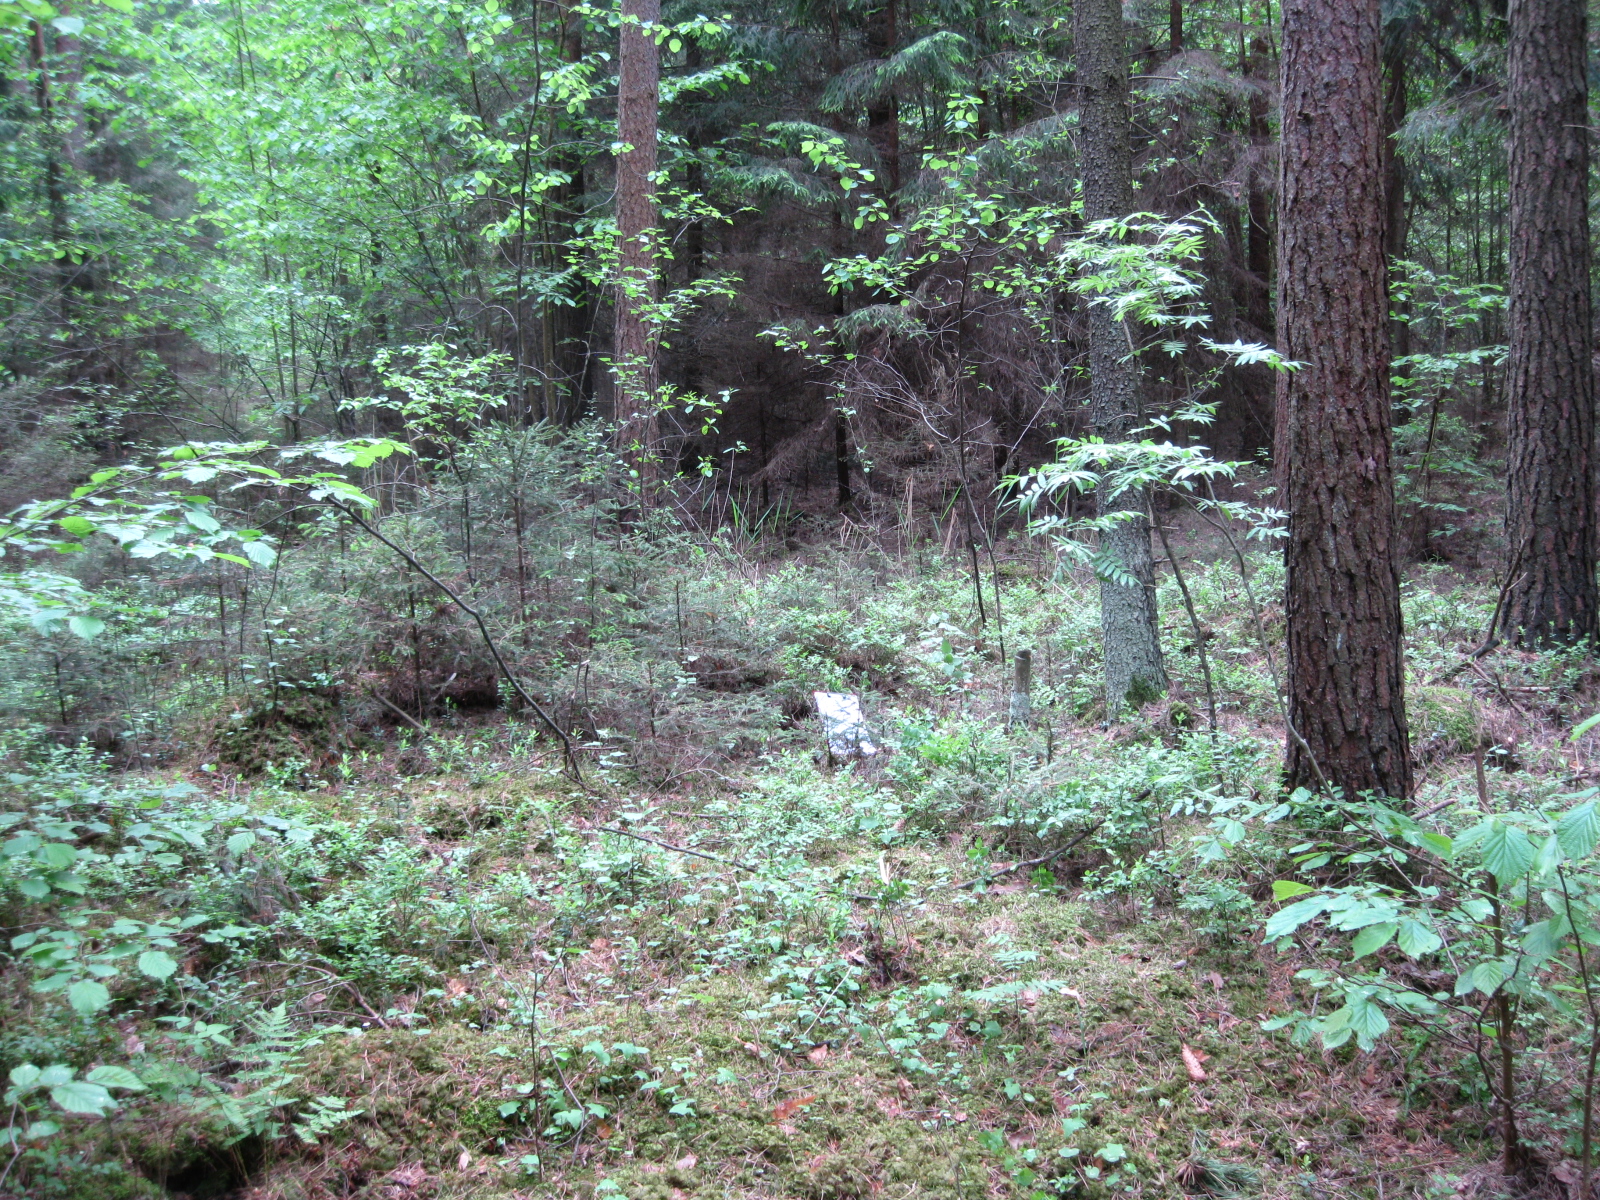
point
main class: Woodland
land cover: Other coniferous woodland
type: hemiboreal forest and nemoral coniferous forest and mixed broadleaved-coniferous forest
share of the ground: > 75 %
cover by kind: coniferous forest trees 70 %, broadleaved forest trees 10 %, lichens and mosses 10 %, shrubs 5 %, herbaceous plants 5 %
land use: Forestry
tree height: > 5 m
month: June
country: LT
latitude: 55.9801
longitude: 24.1784
